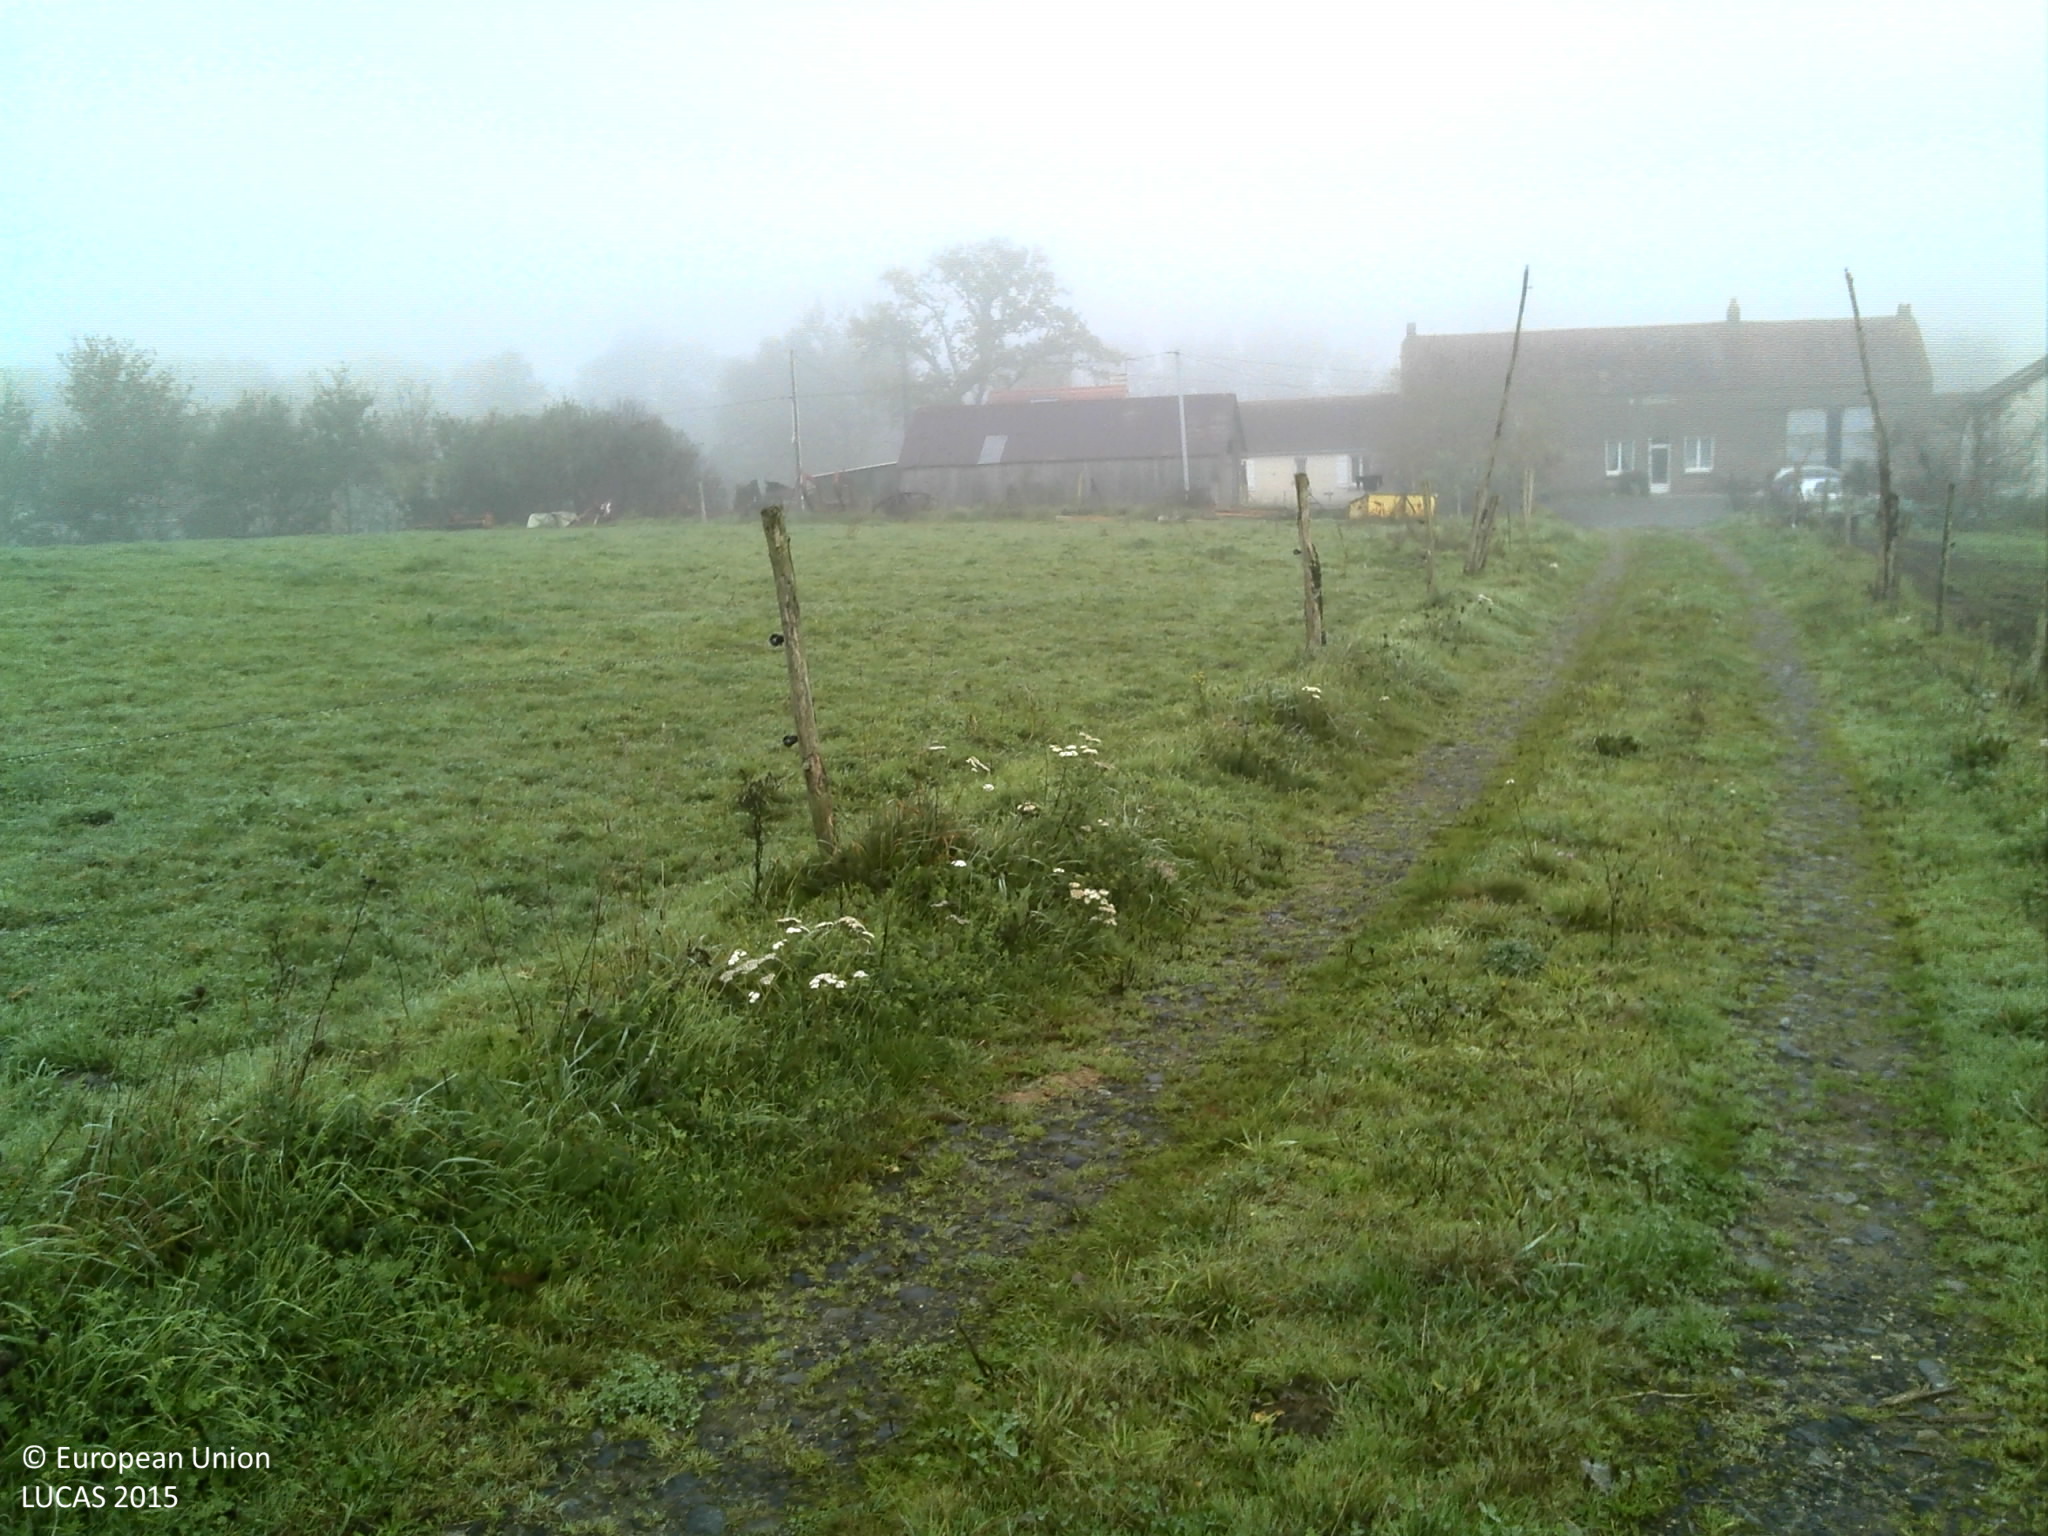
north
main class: Grassland
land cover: Grassland without tree/shrub cover
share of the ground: > 75 %
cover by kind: herbaceous plants 100 %
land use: Agriculture (excluding fallow land and kitchen gardens)
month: November
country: FR
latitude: 47.3373
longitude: -1.7579
